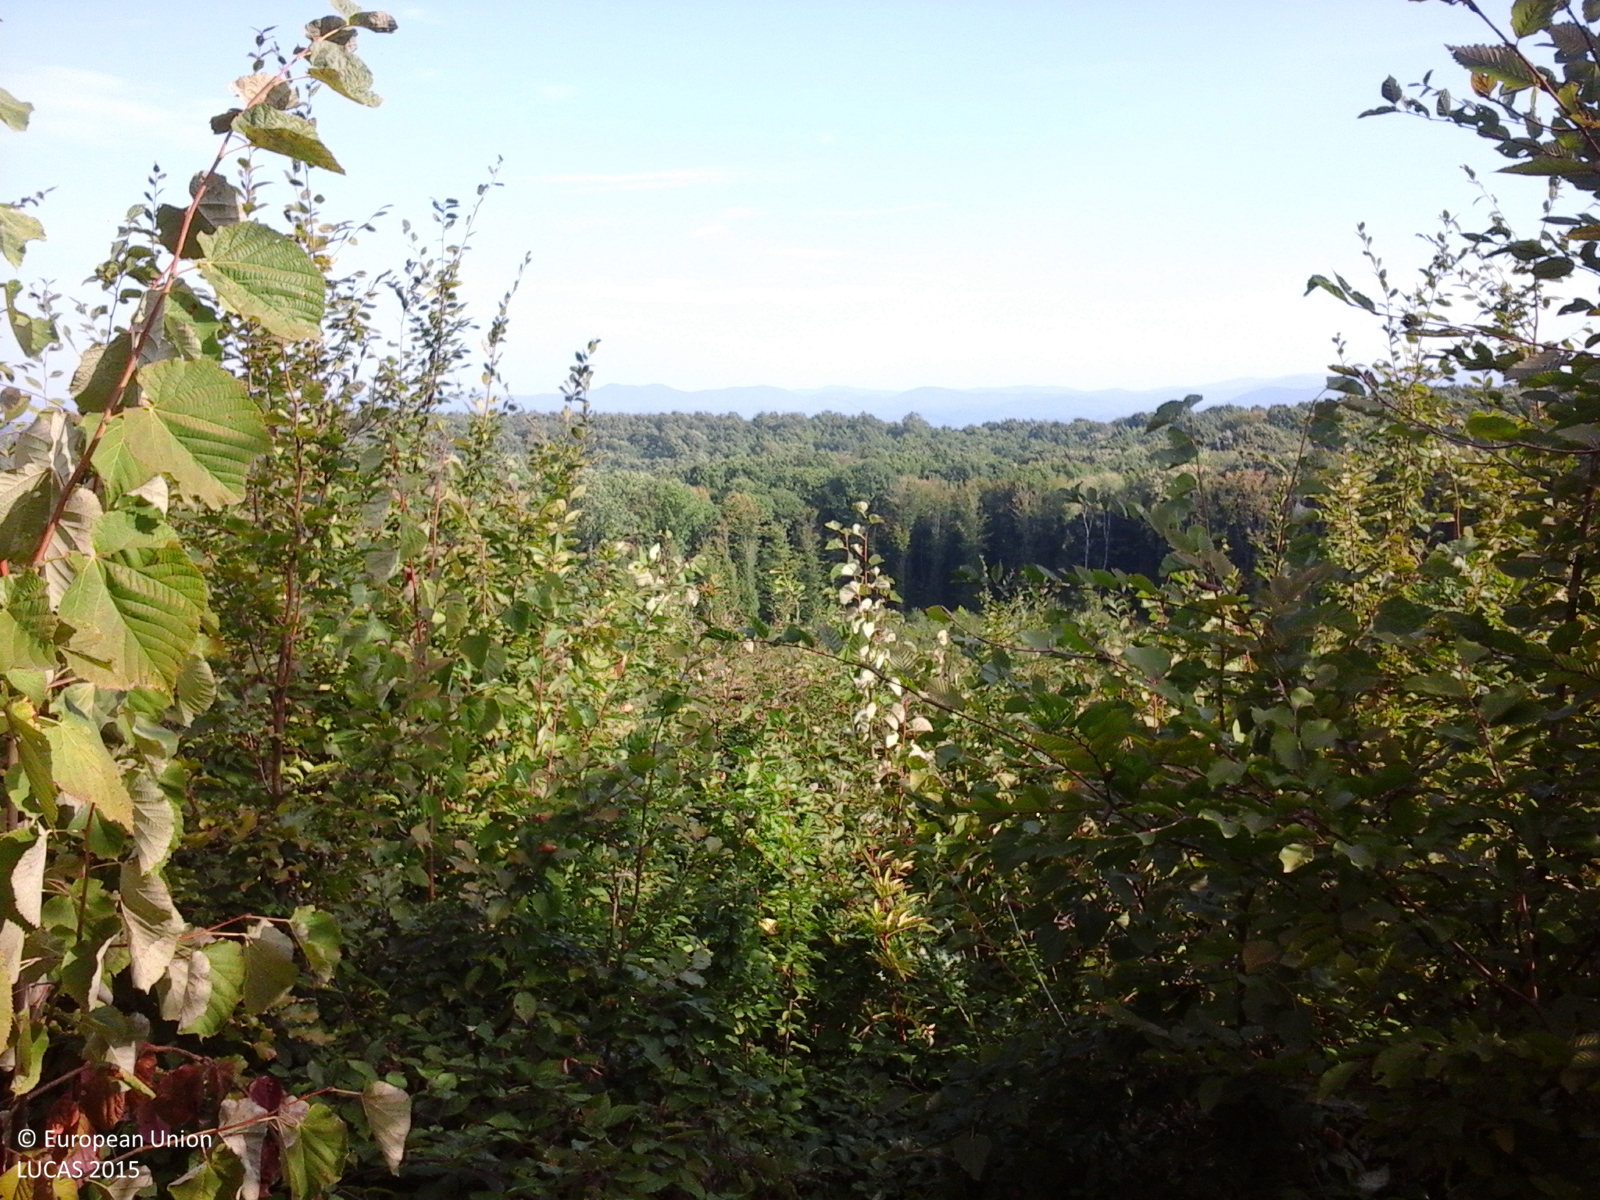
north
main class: Woodland
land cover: Broadleaved woodland
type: acidophilous oak and oak-birch forest
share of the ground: > 75 %
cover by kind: broadleaved forest trees 95 %, herbaceous plants 5 %
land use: Forestry
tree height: < 5 m
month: September
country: RO
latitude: 45.4761
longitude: 22.1287
